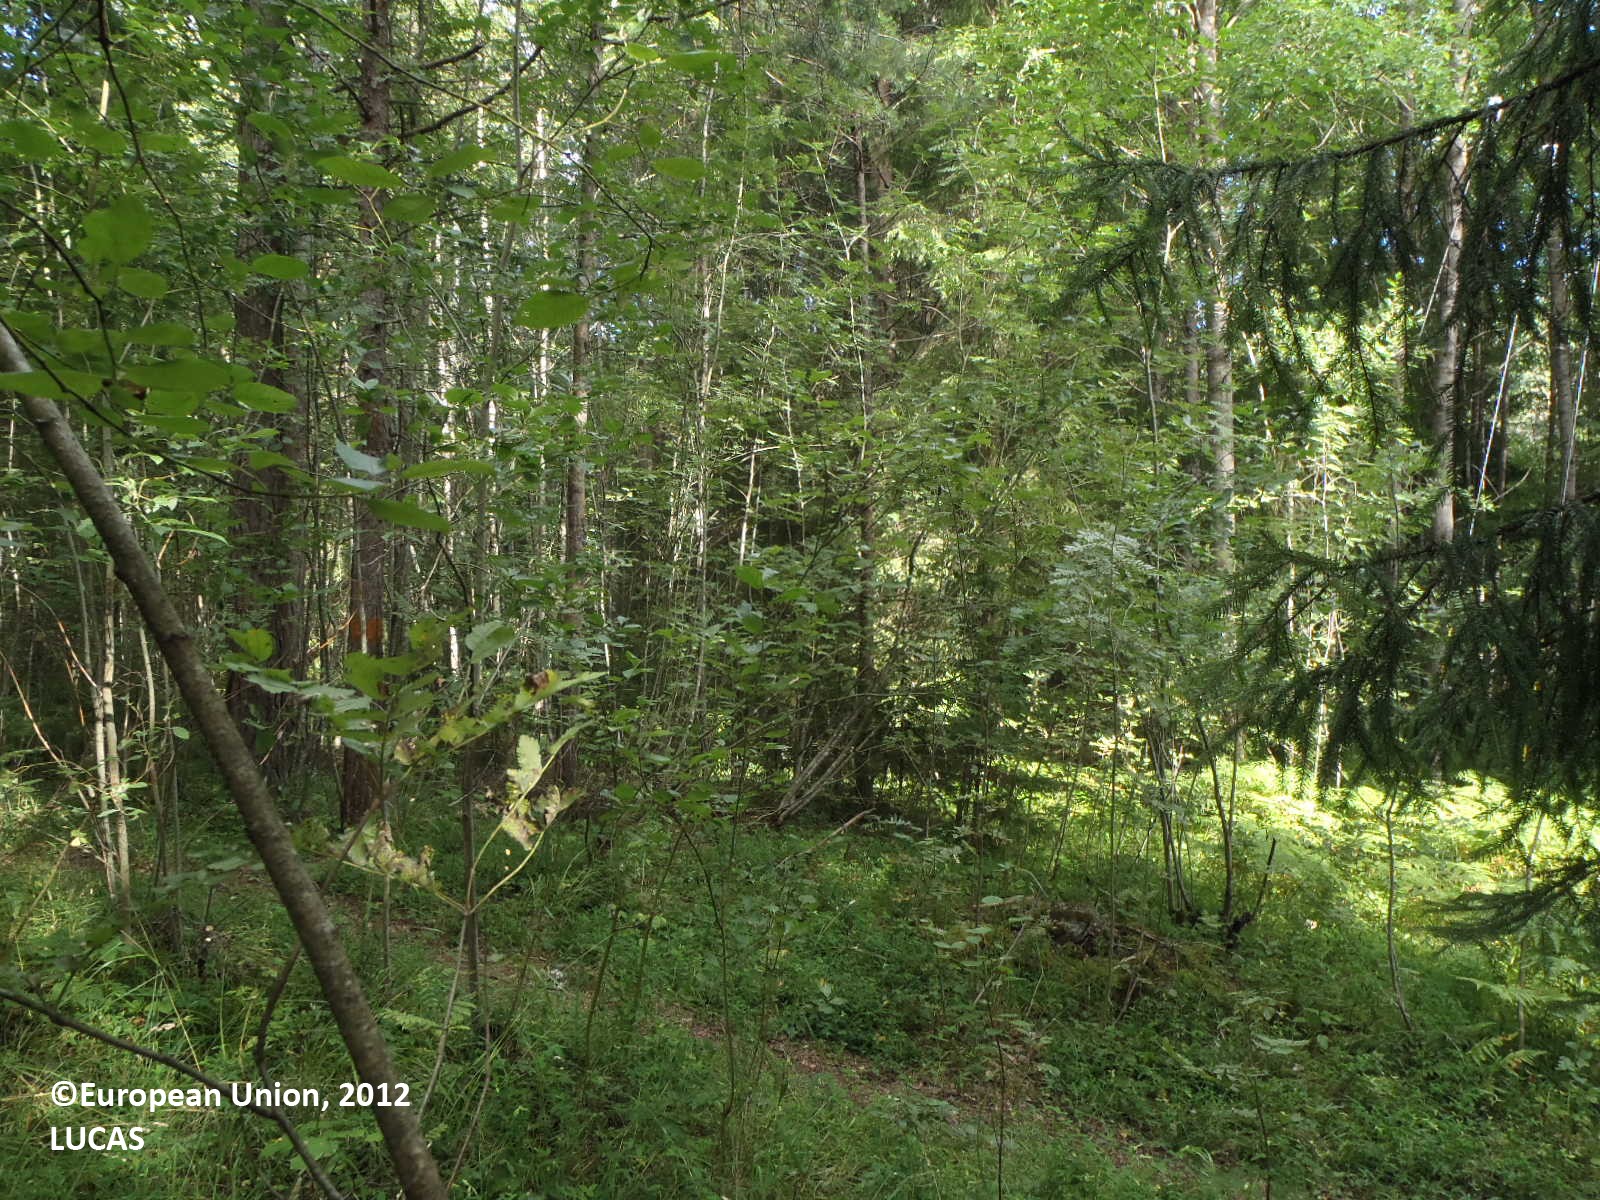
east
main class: Woodland
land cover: Spruce dominated mixed woodland
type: boreal forest
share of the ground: > 75 %
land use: Forestry
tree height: > 5 m
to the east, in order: Spruce dominated mixed woodland; Grassland with sparse tree/shrub cover; Electric lines; Grassland with sparse tree/shrub cover; Tracks; Pine dominated mixed woodland; Broadleaved woodland
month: August
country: FI
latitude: 60.2955
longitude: 22.3169
